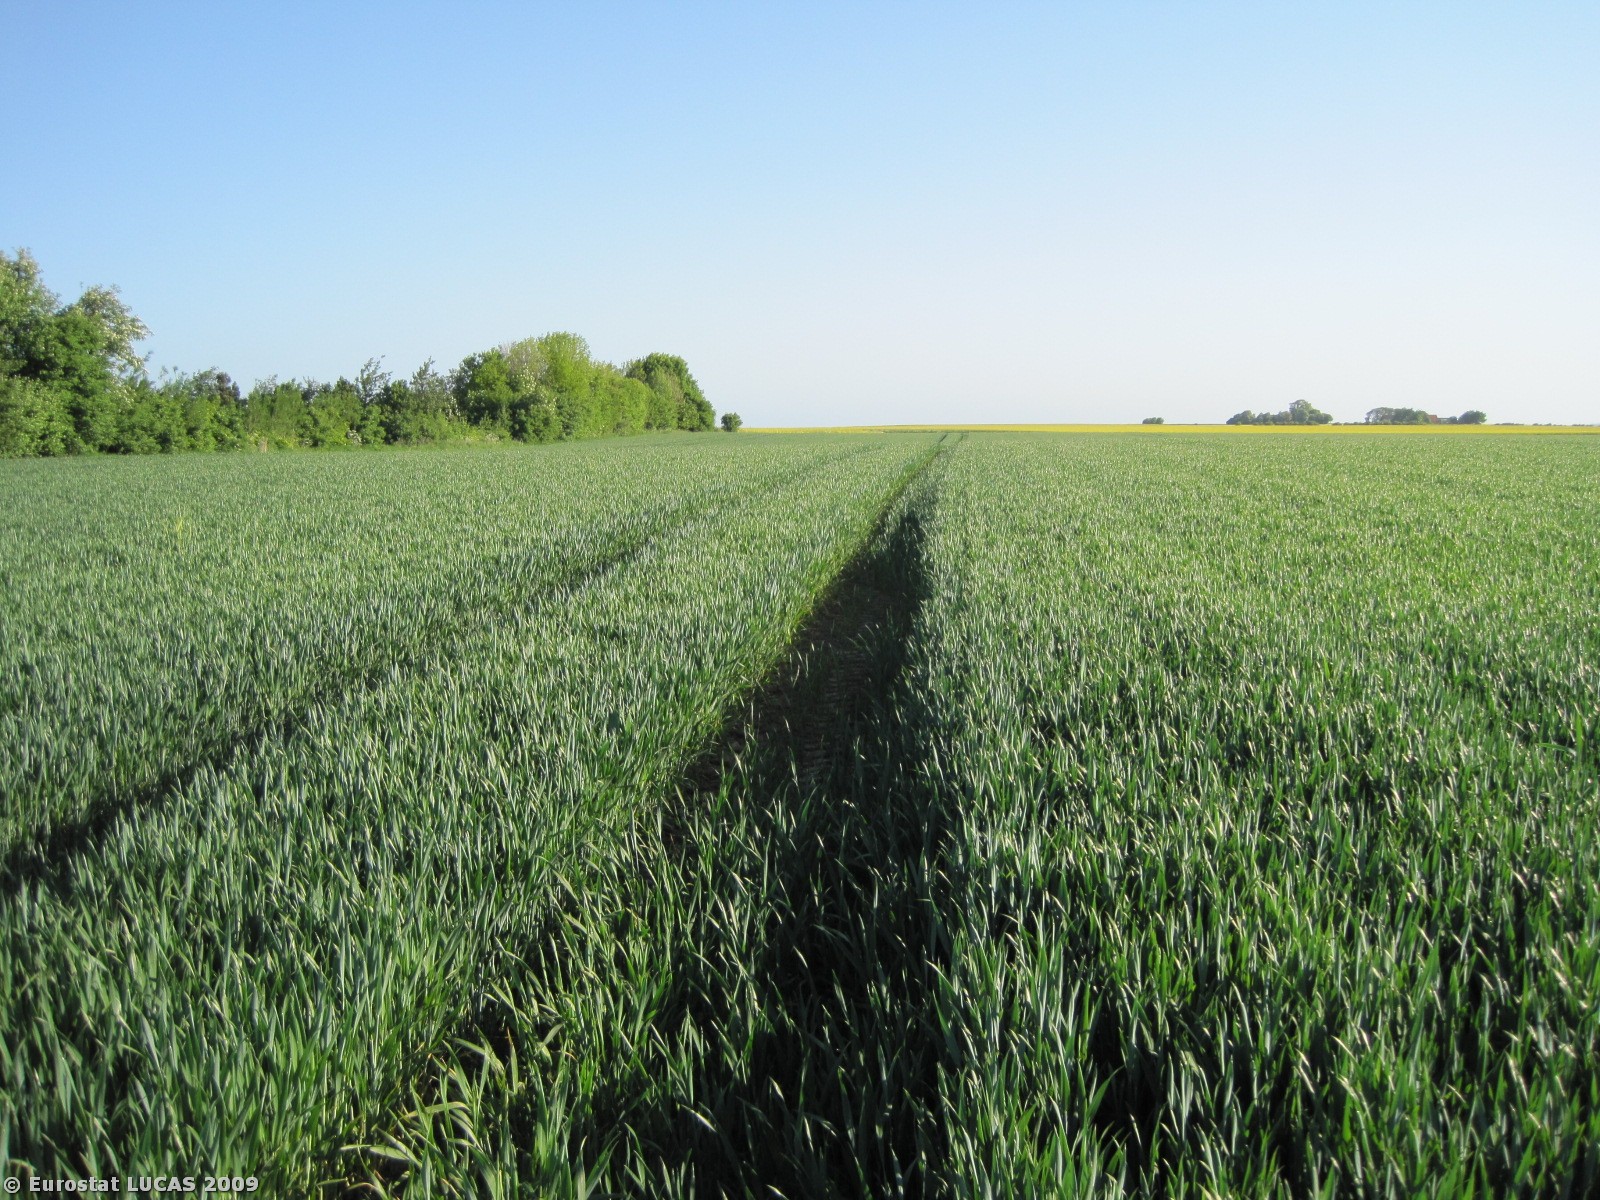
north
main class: Cropland
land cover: Common wheat
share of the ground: > 75 %
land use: Agriculture (excluding fallow land and kitchen gardens)
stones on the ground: < 10 %
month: May
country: DK
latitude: 56.6190
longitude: 10.2116
